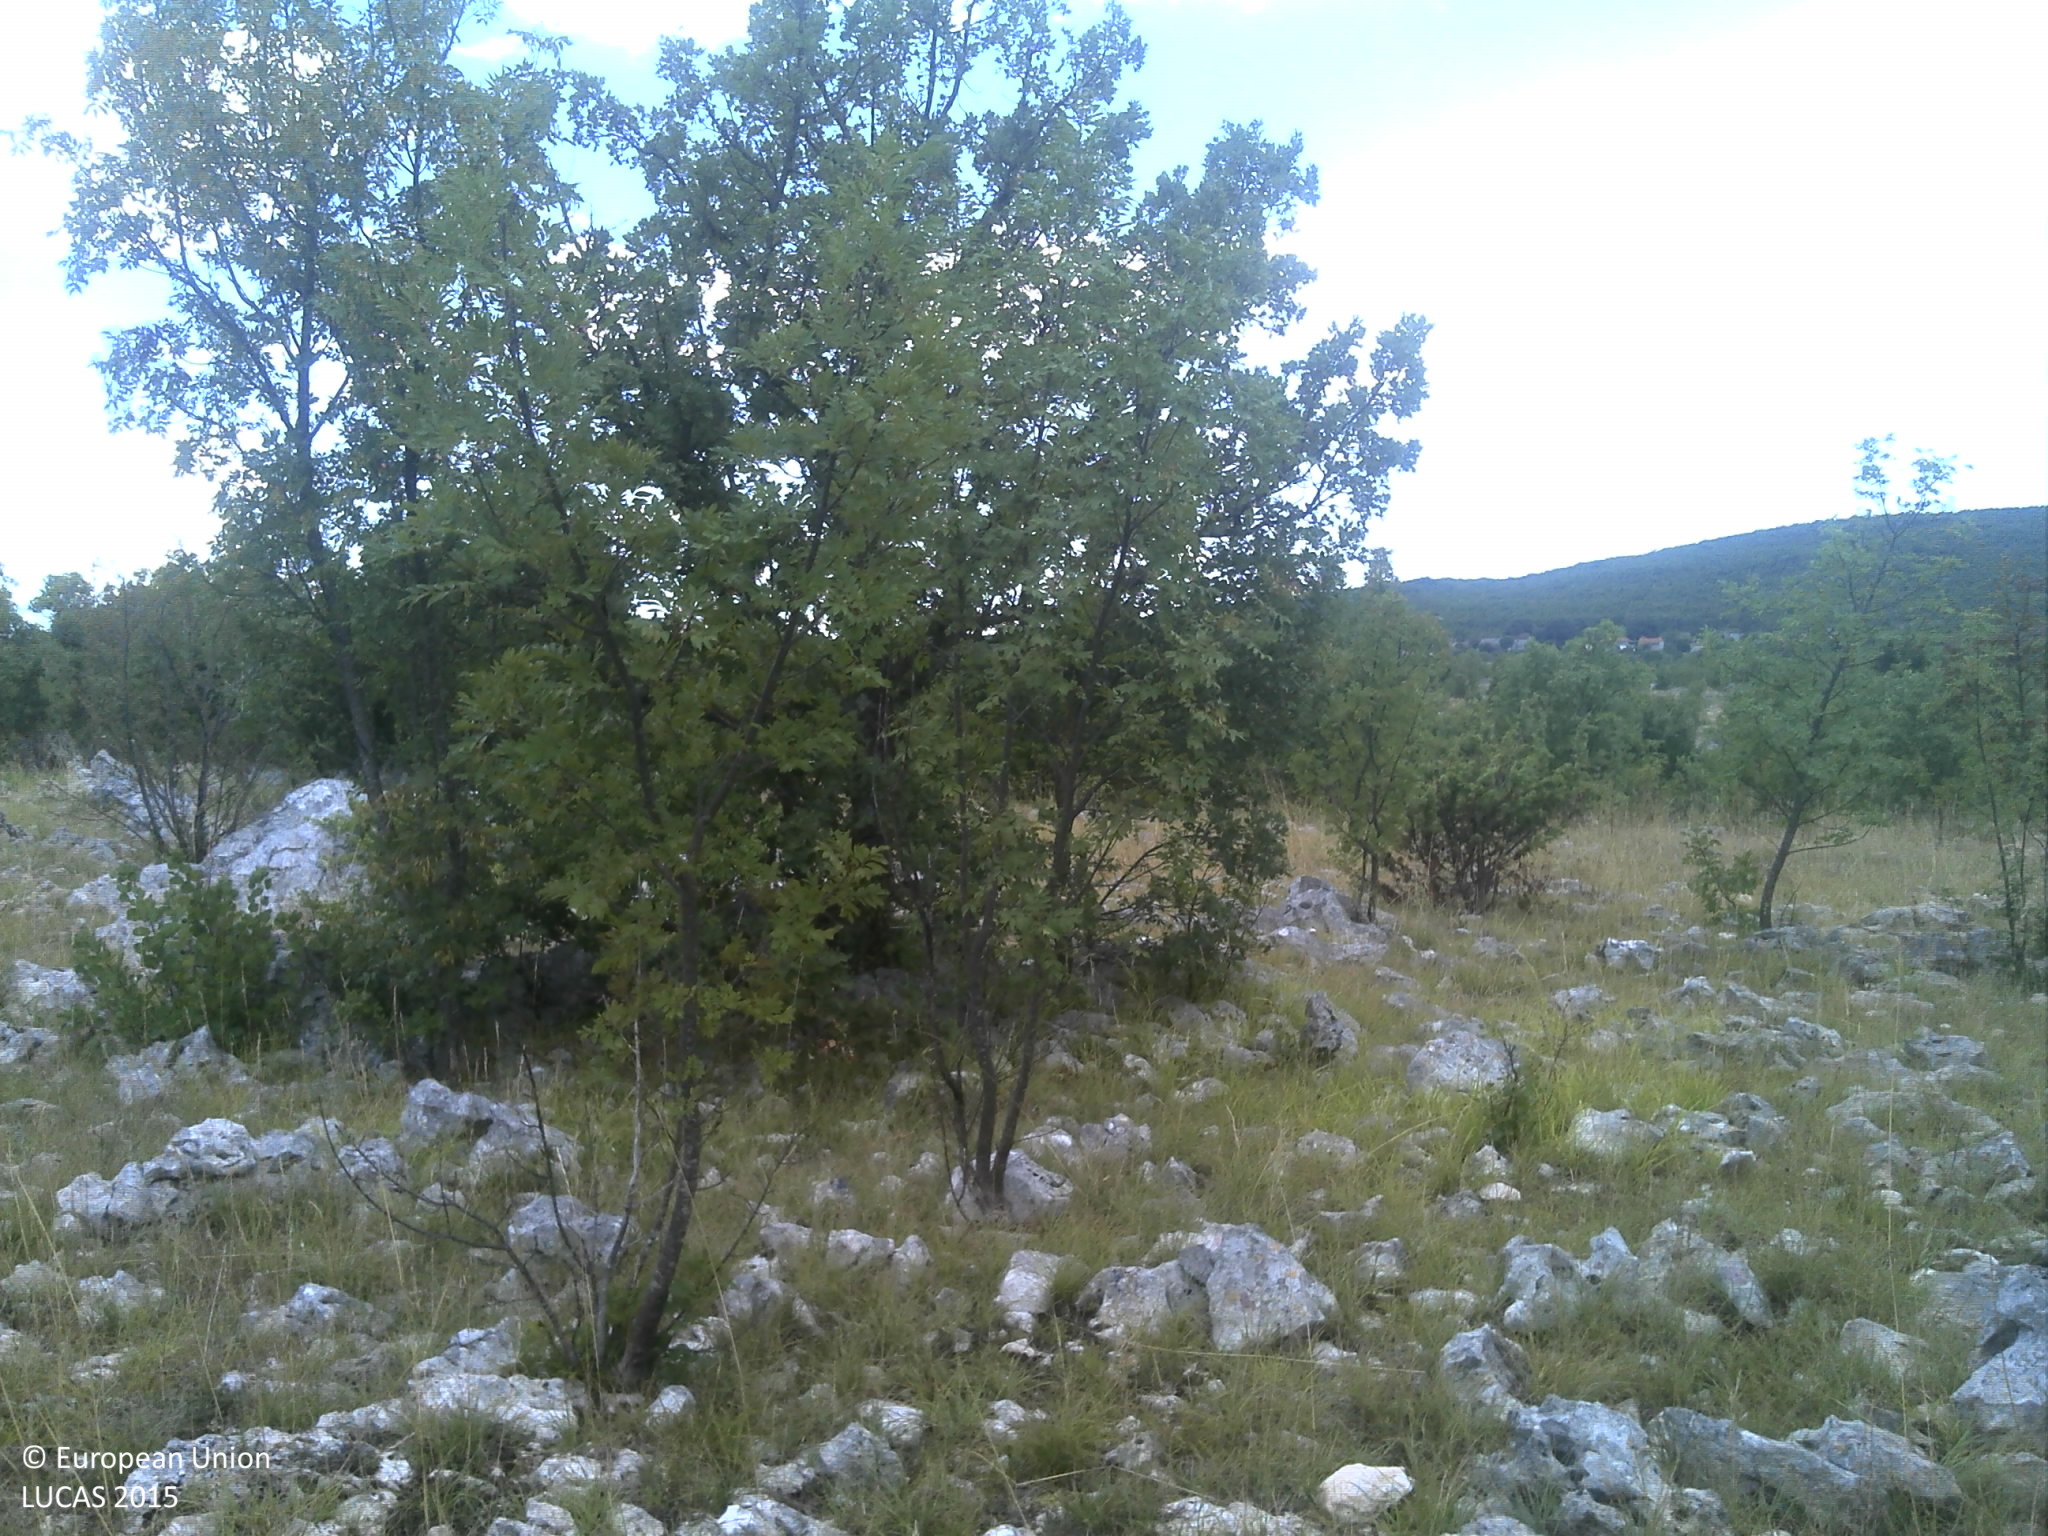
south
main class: Shrubland
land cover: Shrubland with sparse tree cover
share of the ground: 25 - 50 %
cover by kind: shrubs 35 %, herbaceous plants 30 %, unconsolidated bare surface 20 %, consolidated bare surface 10 %, broadleaved forest trees 5 %
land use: Semi-natural and natural areas not in use
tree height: < 5 m
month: August
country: HR
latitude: 43.6073
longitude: 16.4461
